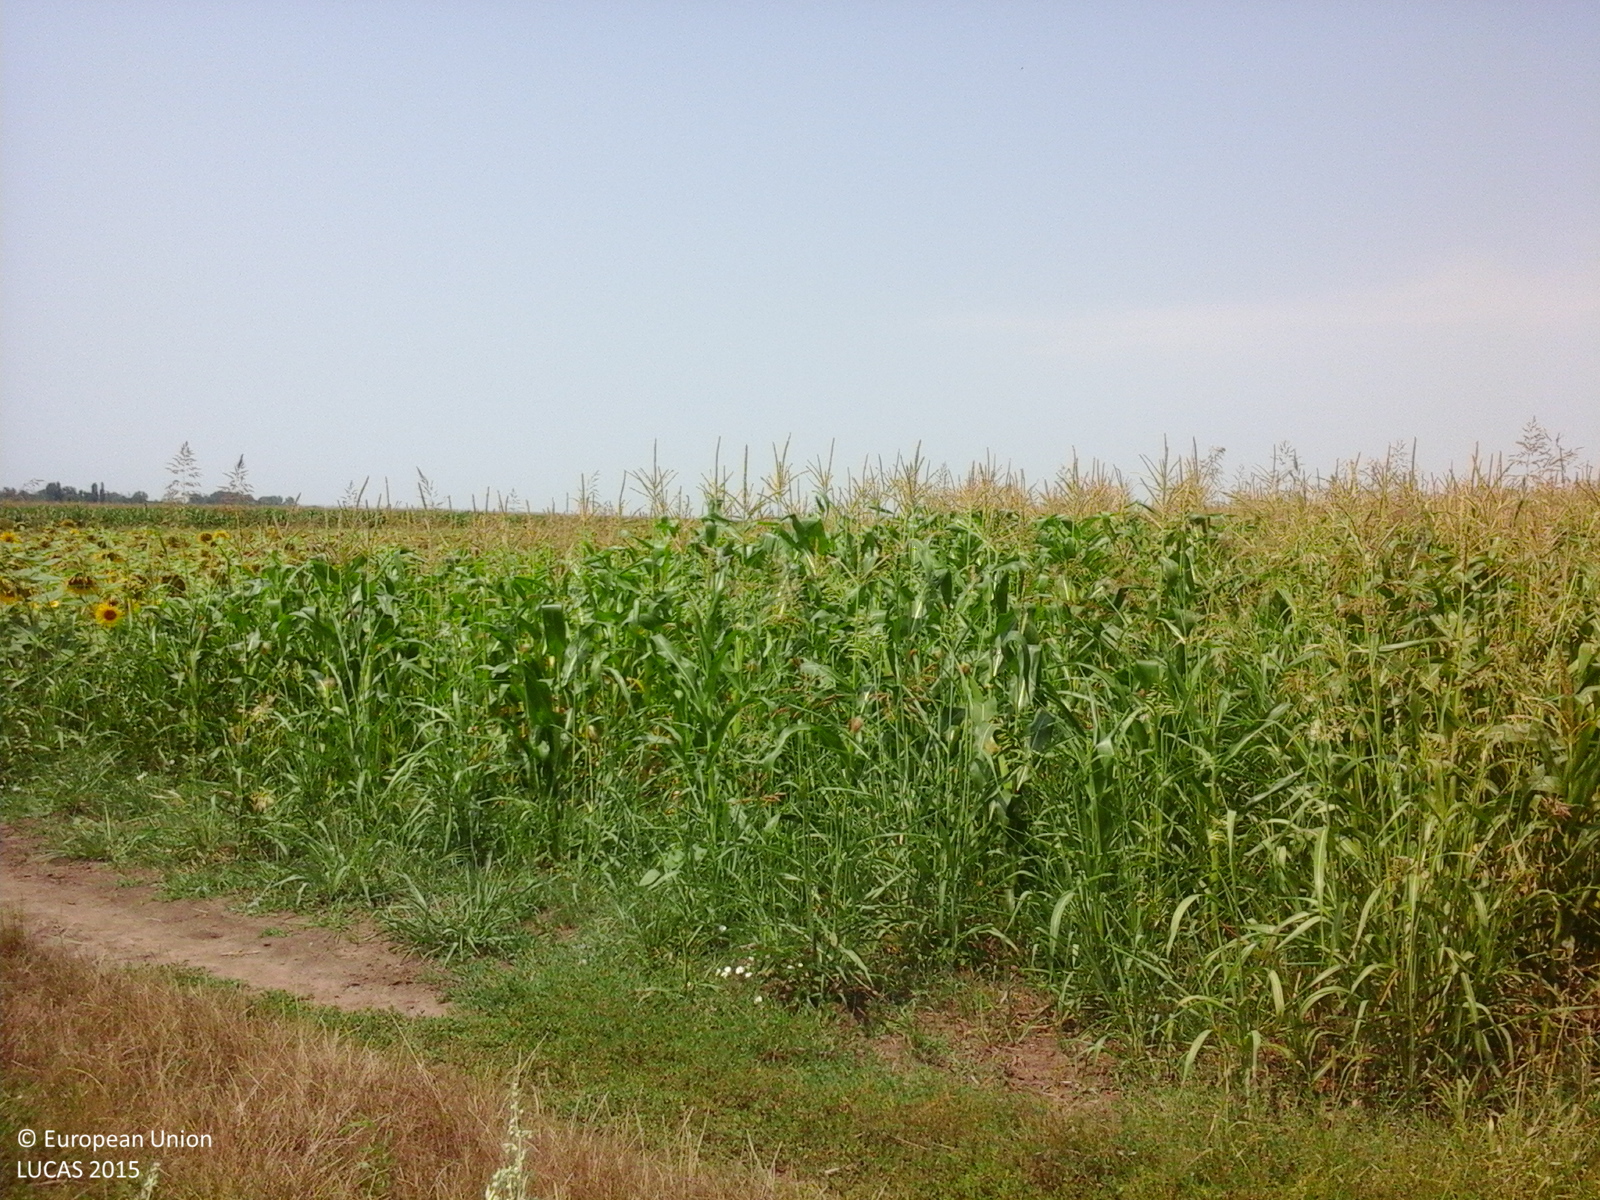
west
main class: Cropland
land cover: Lucerne
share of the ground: 50 - 75 %
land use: Agriculture (excluding fallow land and kitchen gardens)
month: July
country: RO
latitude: 44.6172
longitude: 26.6162
